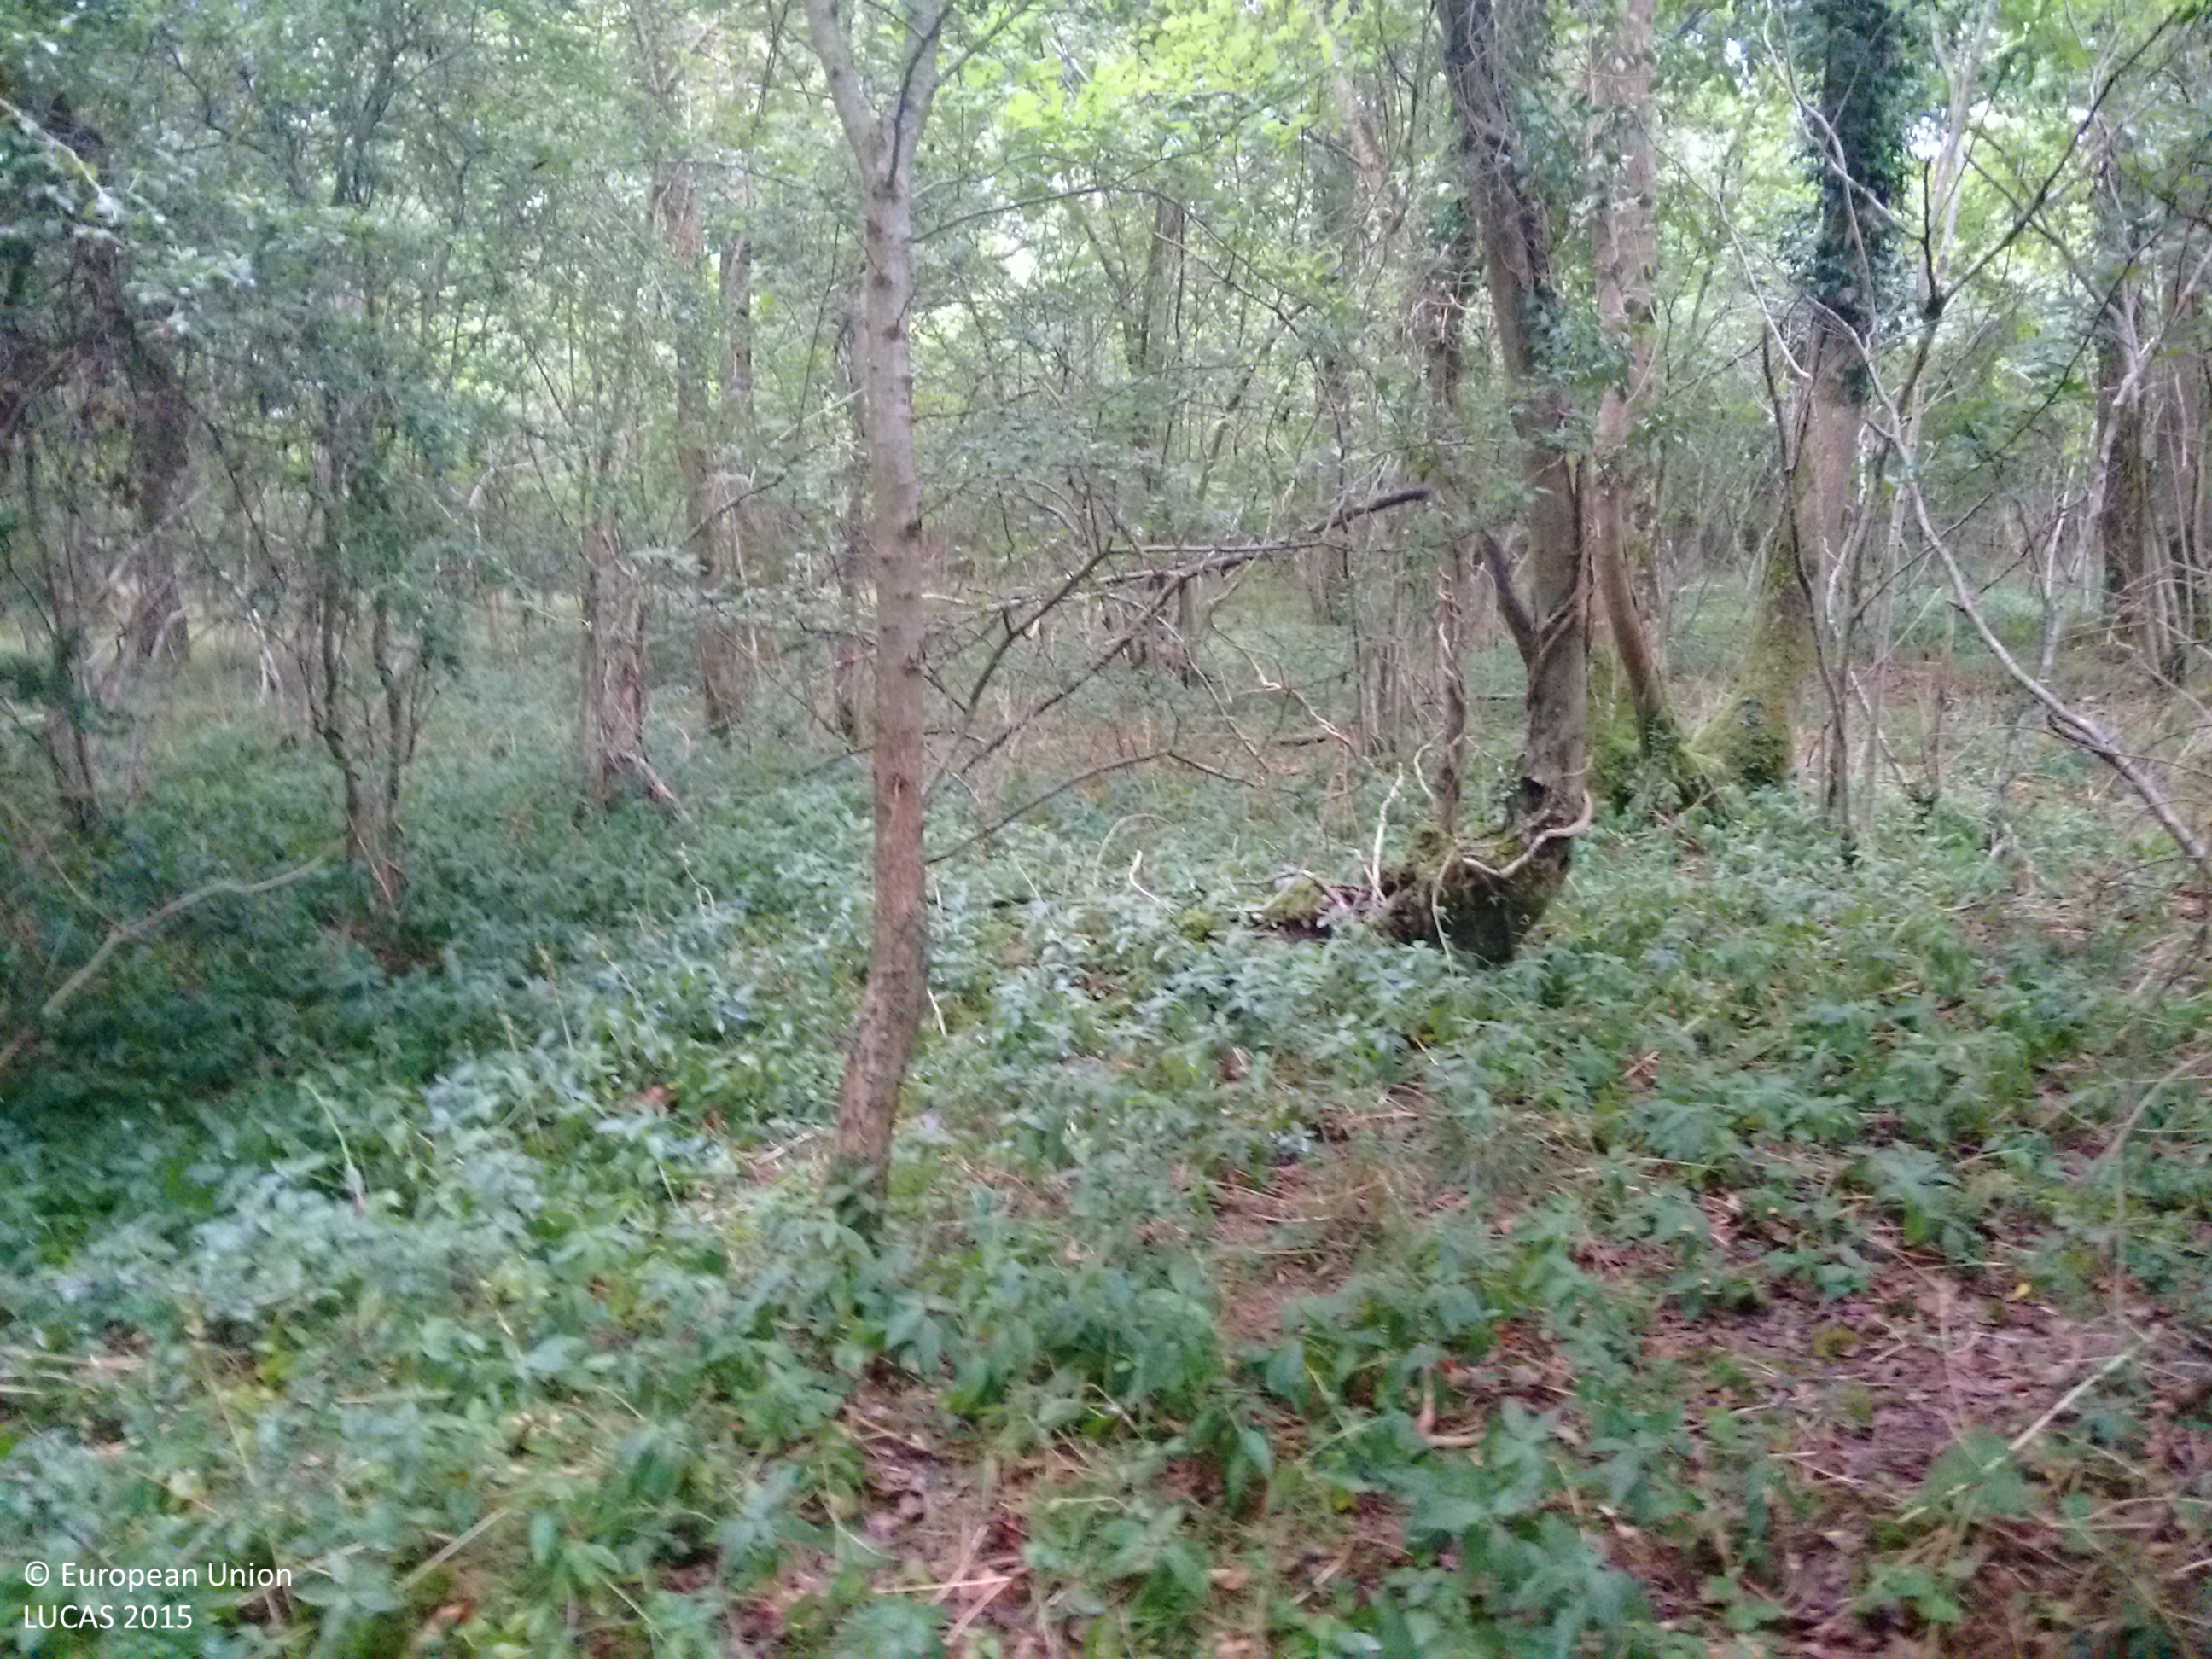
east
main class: Woodland
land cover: Broadleaved woodland
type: mesophytic deciduous forest
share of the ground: > 75 %
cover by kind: broadleaved forest trees 100 %
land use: Other primary production
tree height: > 5 m
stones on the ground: < 10 %
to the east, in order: Broadleaved woodland; Tracks; Broadleaved woodland; Tracks; Managed hedges; Grass margins; Barley
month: July
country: GB
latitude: 50.7442
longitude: -2.2065
